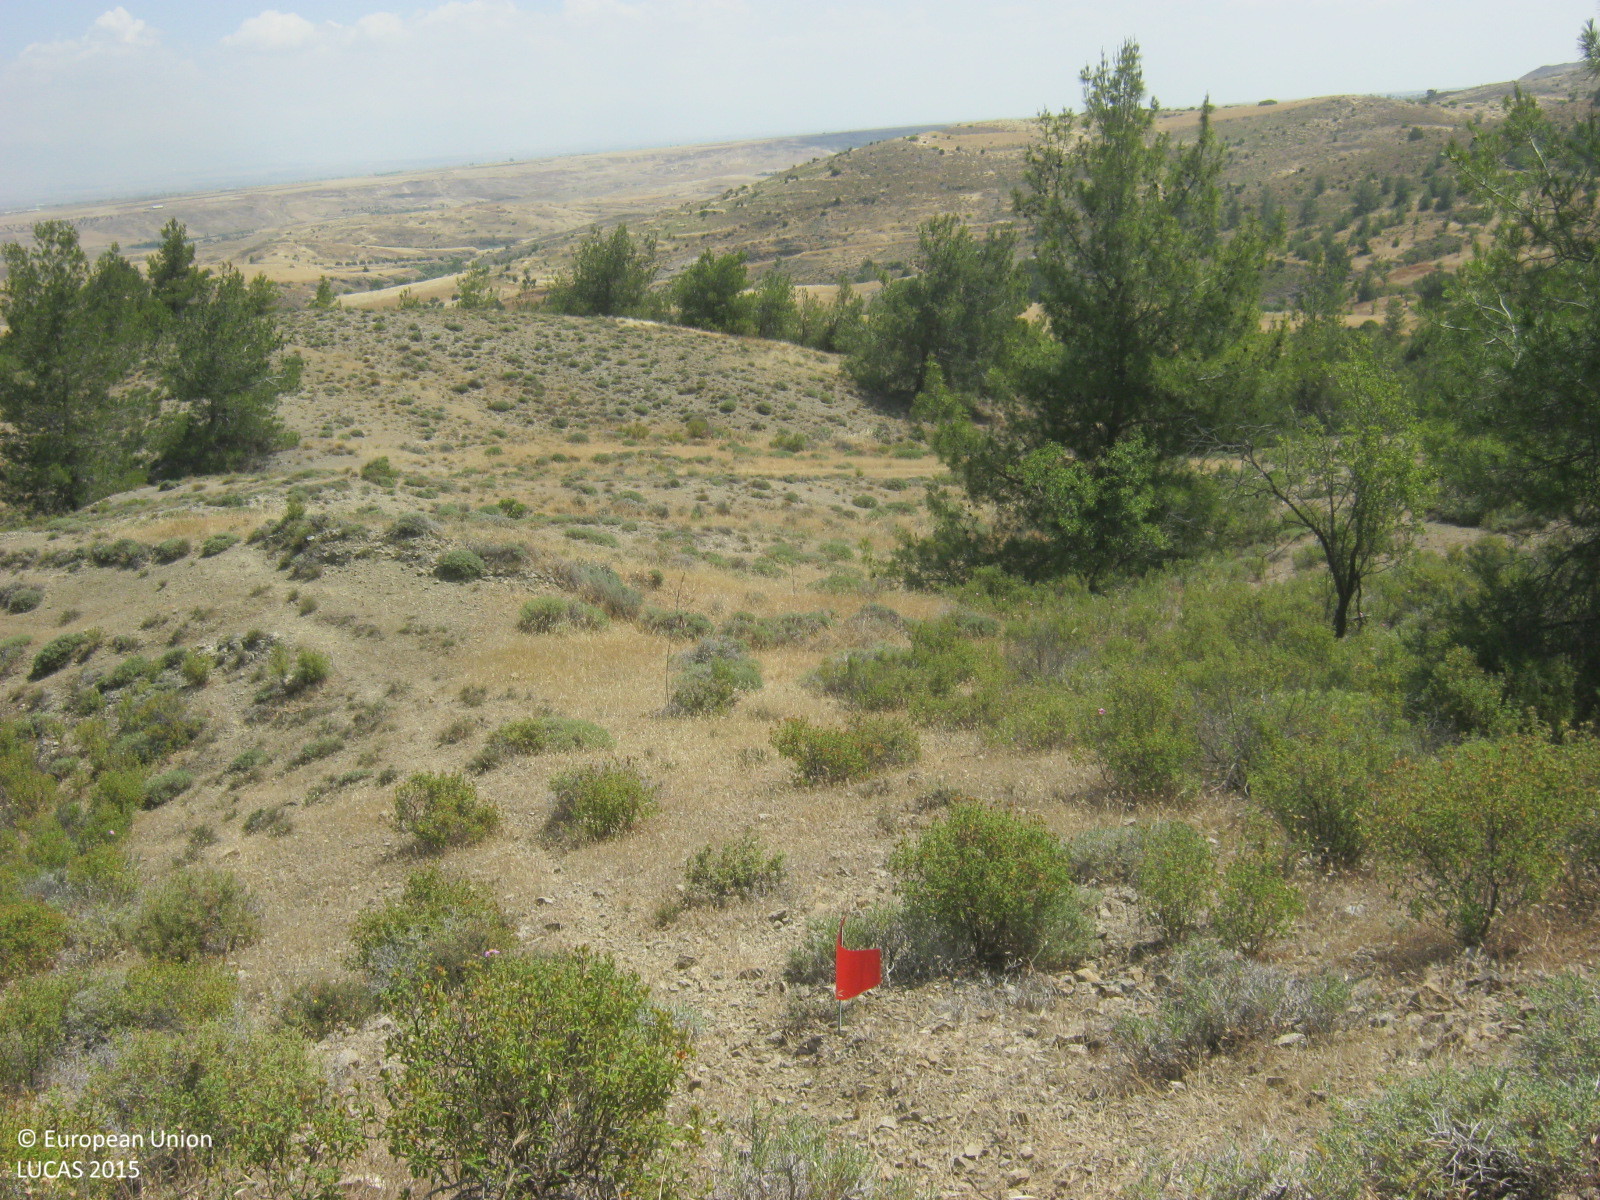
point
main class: Shrubland
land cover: Shrubland with sparse tree cover
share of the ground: 25 - 50 %
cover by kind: shrubs 65 %, unconsolidated bare surface 20 %, herbaceous plants 10 %, coniferous forest trees 5 %
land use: Forestry
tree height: > 5 m
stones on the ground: 25 - 50 %
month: May
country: CY
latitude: 35.0649
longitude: 33.0405
